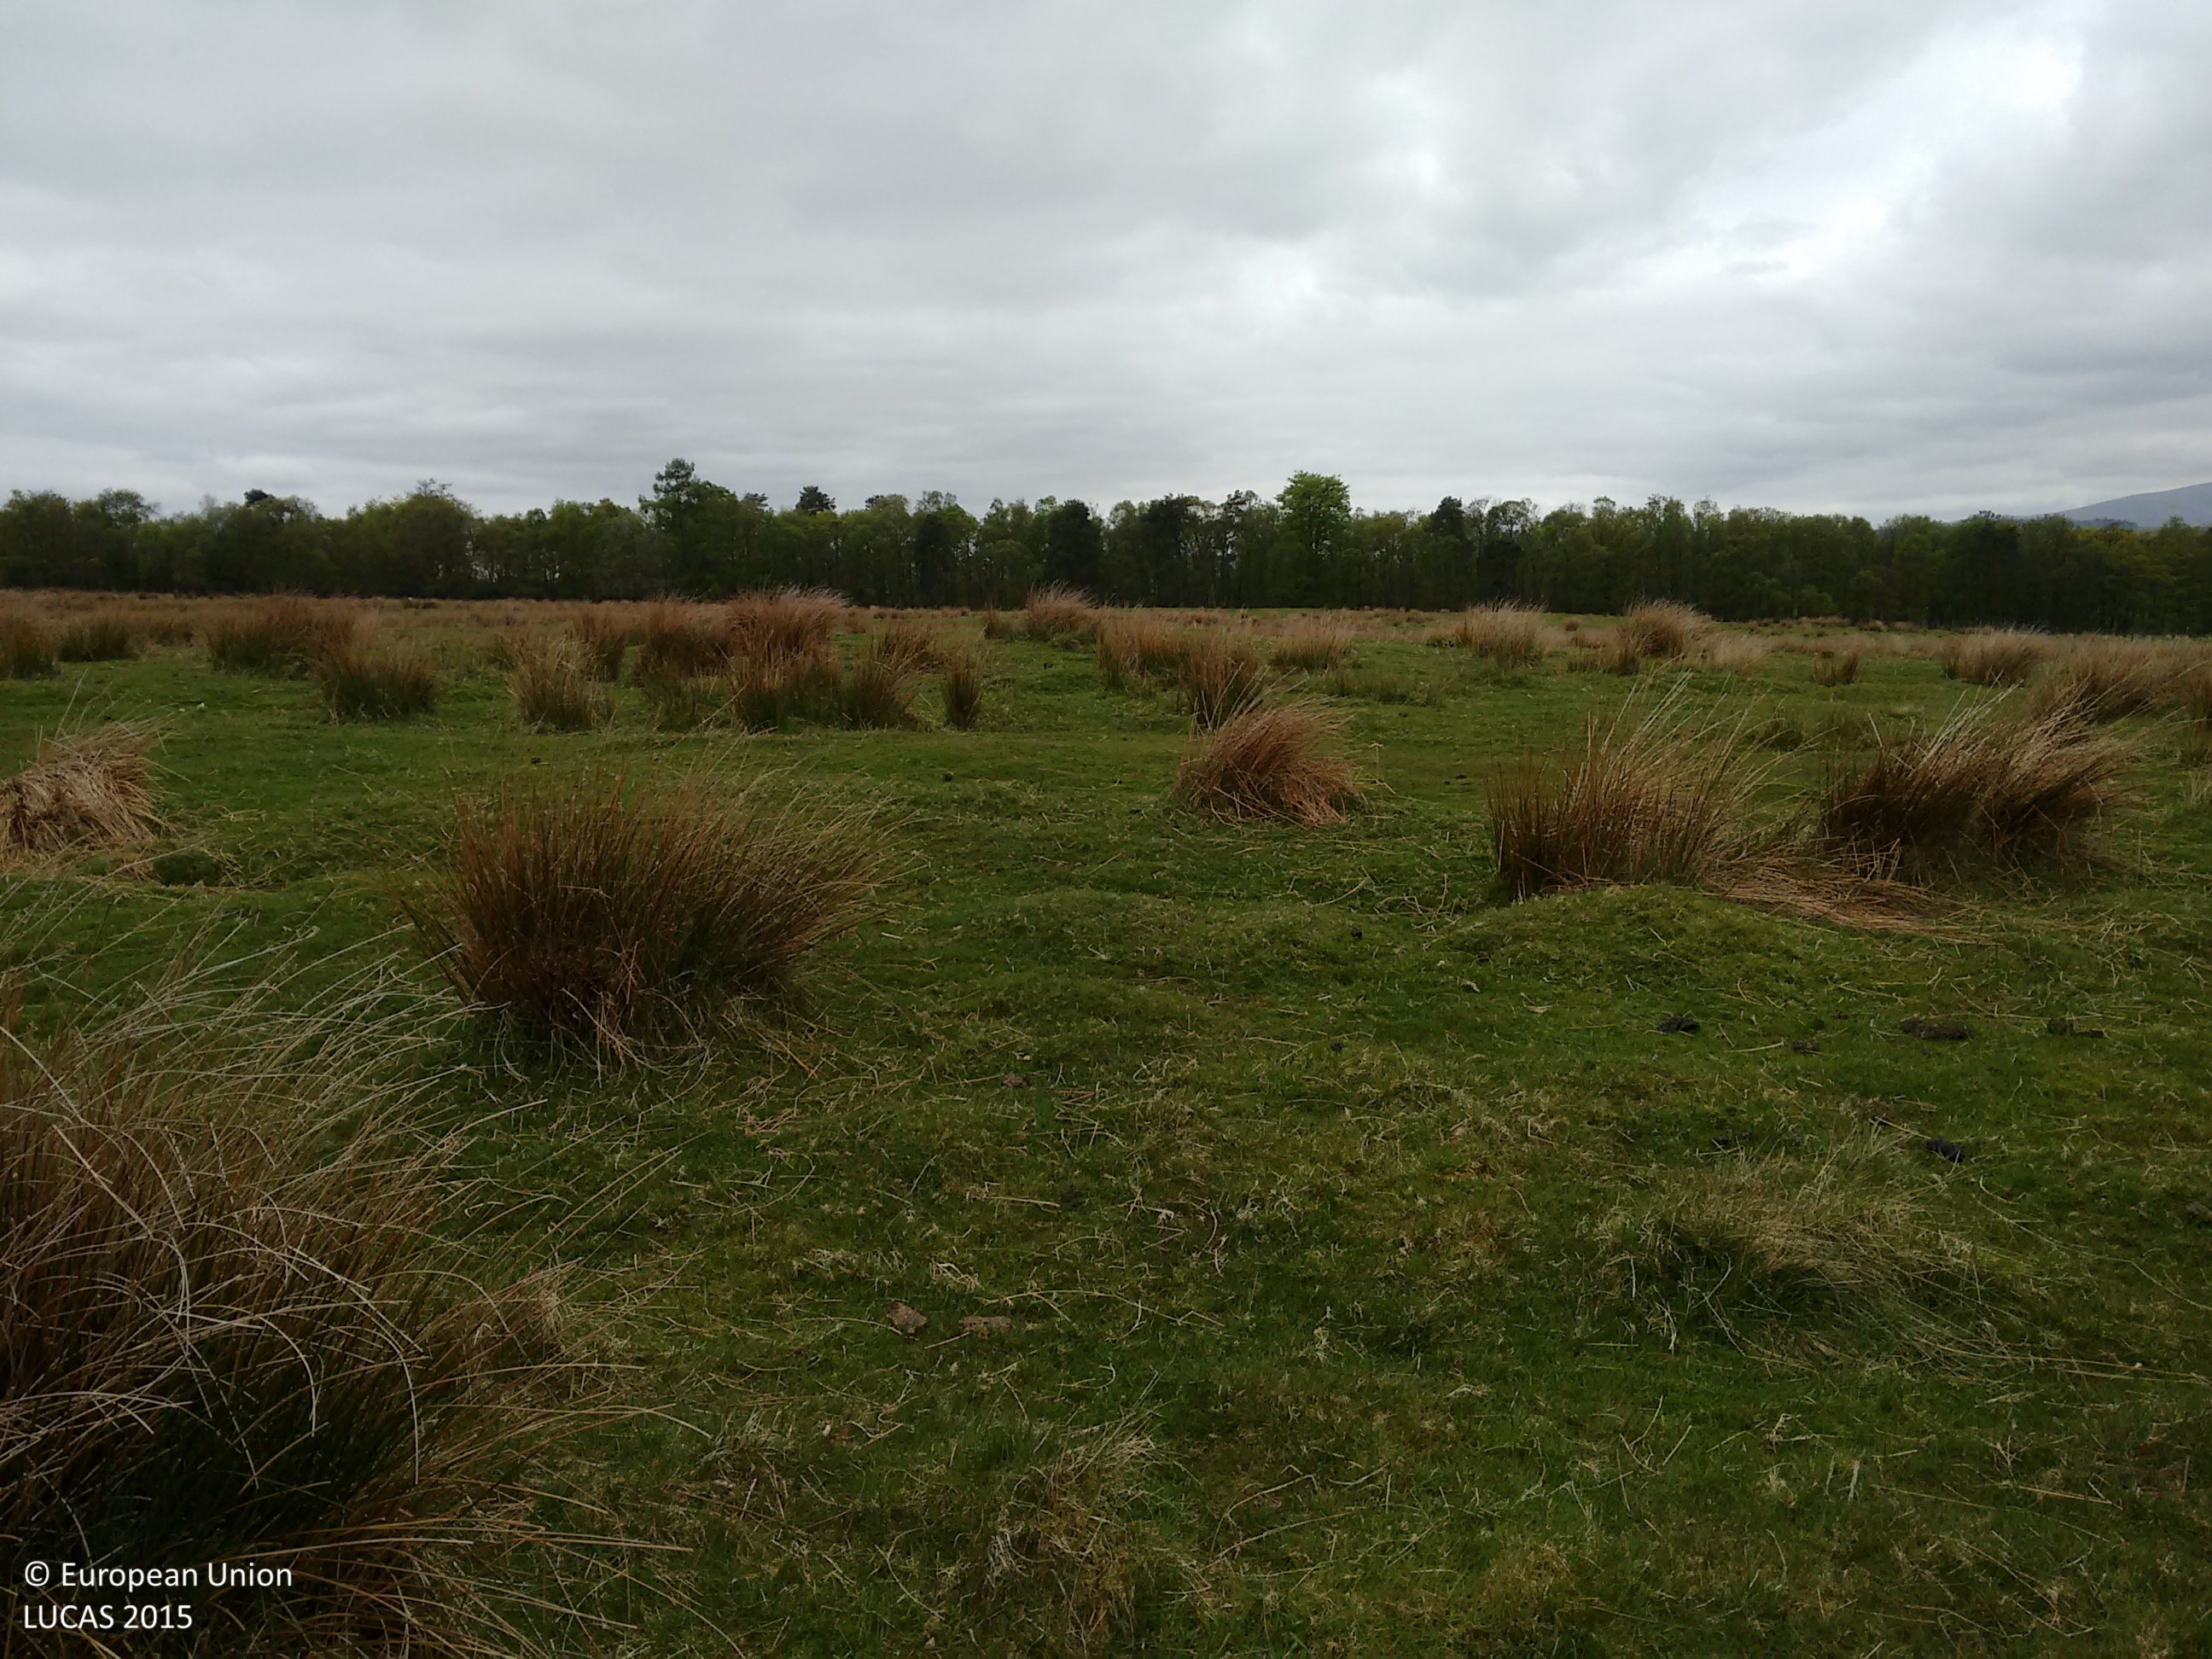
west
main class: Grassland
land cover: Grassland without tree/shrub cover
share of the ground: > 75 %
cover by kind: herbaceous plants 95 %, lichens and mosses 5 %
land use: Agriculture (excluding fallow land and kitchen gardens)
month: May
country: GB
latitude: 56.0183
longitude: -4.4878
